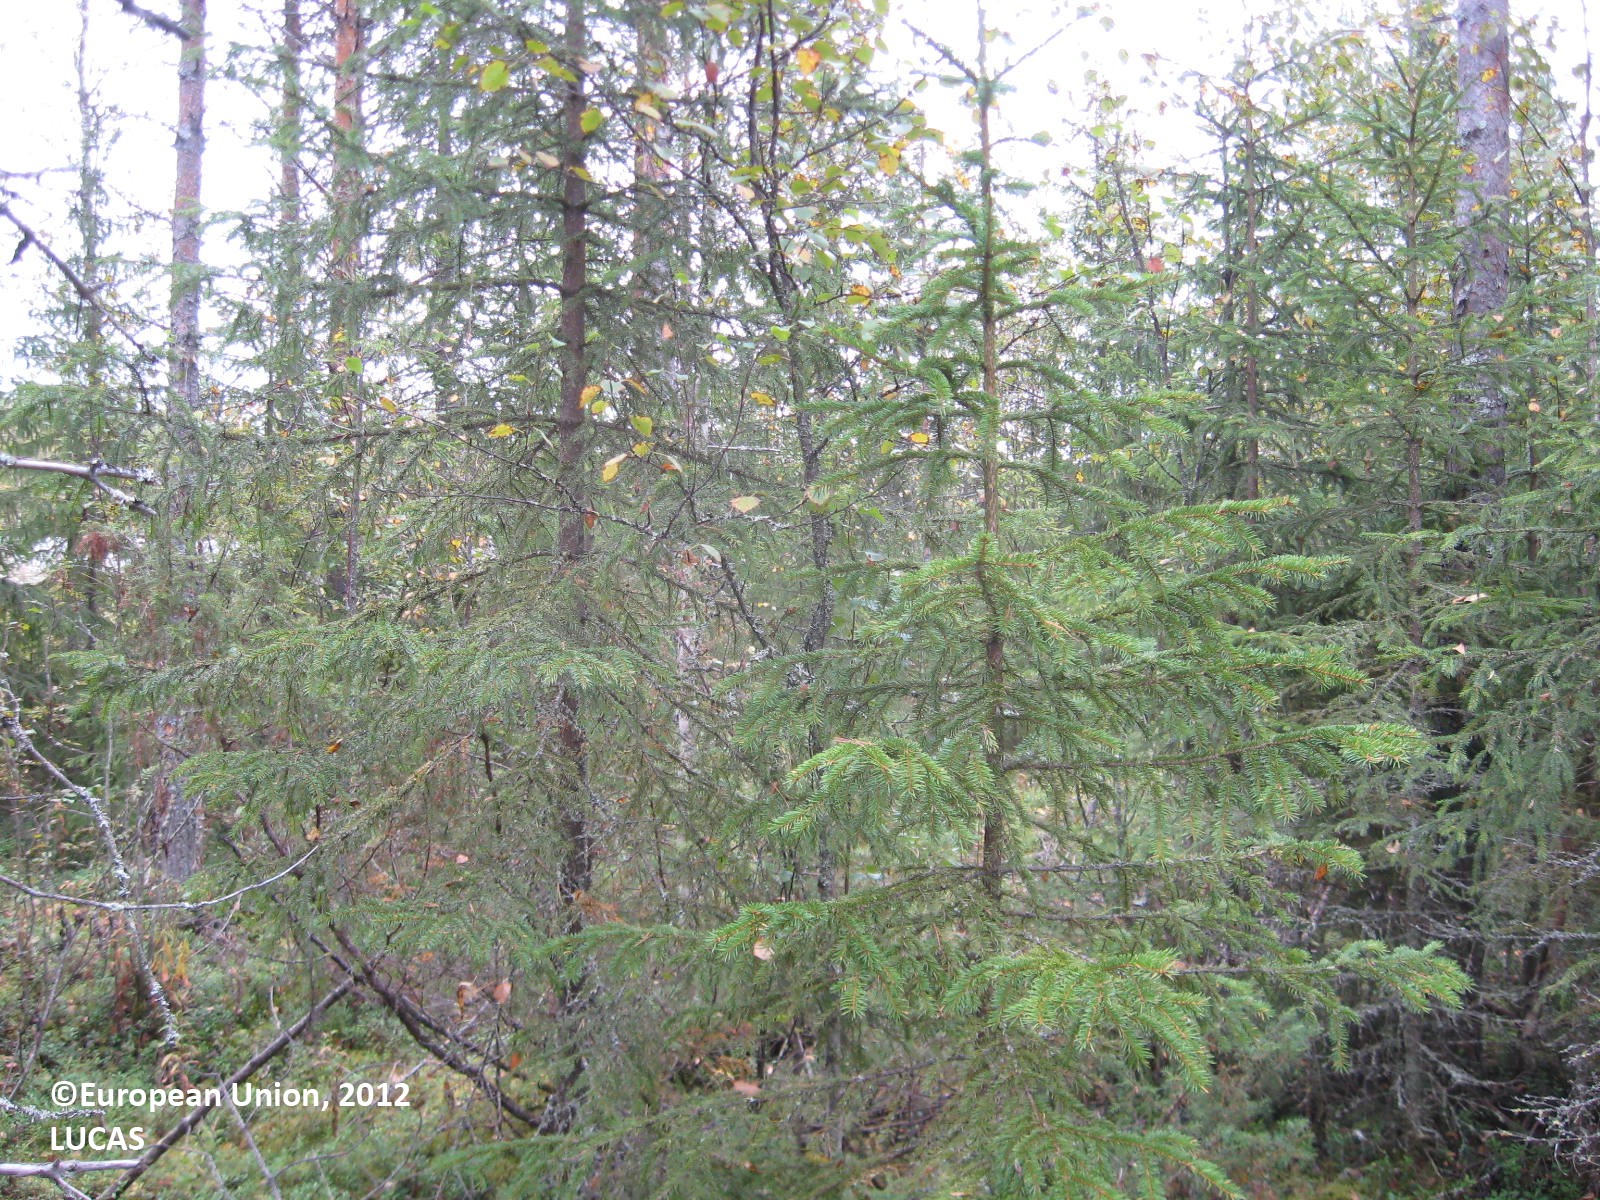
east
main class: Woodland
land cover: Pine dominated coniferous woodland
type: boreal forest
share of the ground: > 75 %
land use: Forestry
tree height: > 5 m
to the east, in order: Pine dominated coniferous woodland; Ditches and canals; Shrubland without tree cover; Railways; Shrubland without tree cover; Ditches and canals; Pine dominated mixed woodland; Other mixed woodland; Broadleaved woodland; Ditches and canals; Other mixed woodland; Pine dominated mixed woodland; Pine dominated coniferous woodland; Ditches and canals; Pine dominated coniferous woodland; Ditches and canals; Pine dominated coniferous woodland
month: September
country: FI
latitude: 64.0196
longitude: 28.3670
